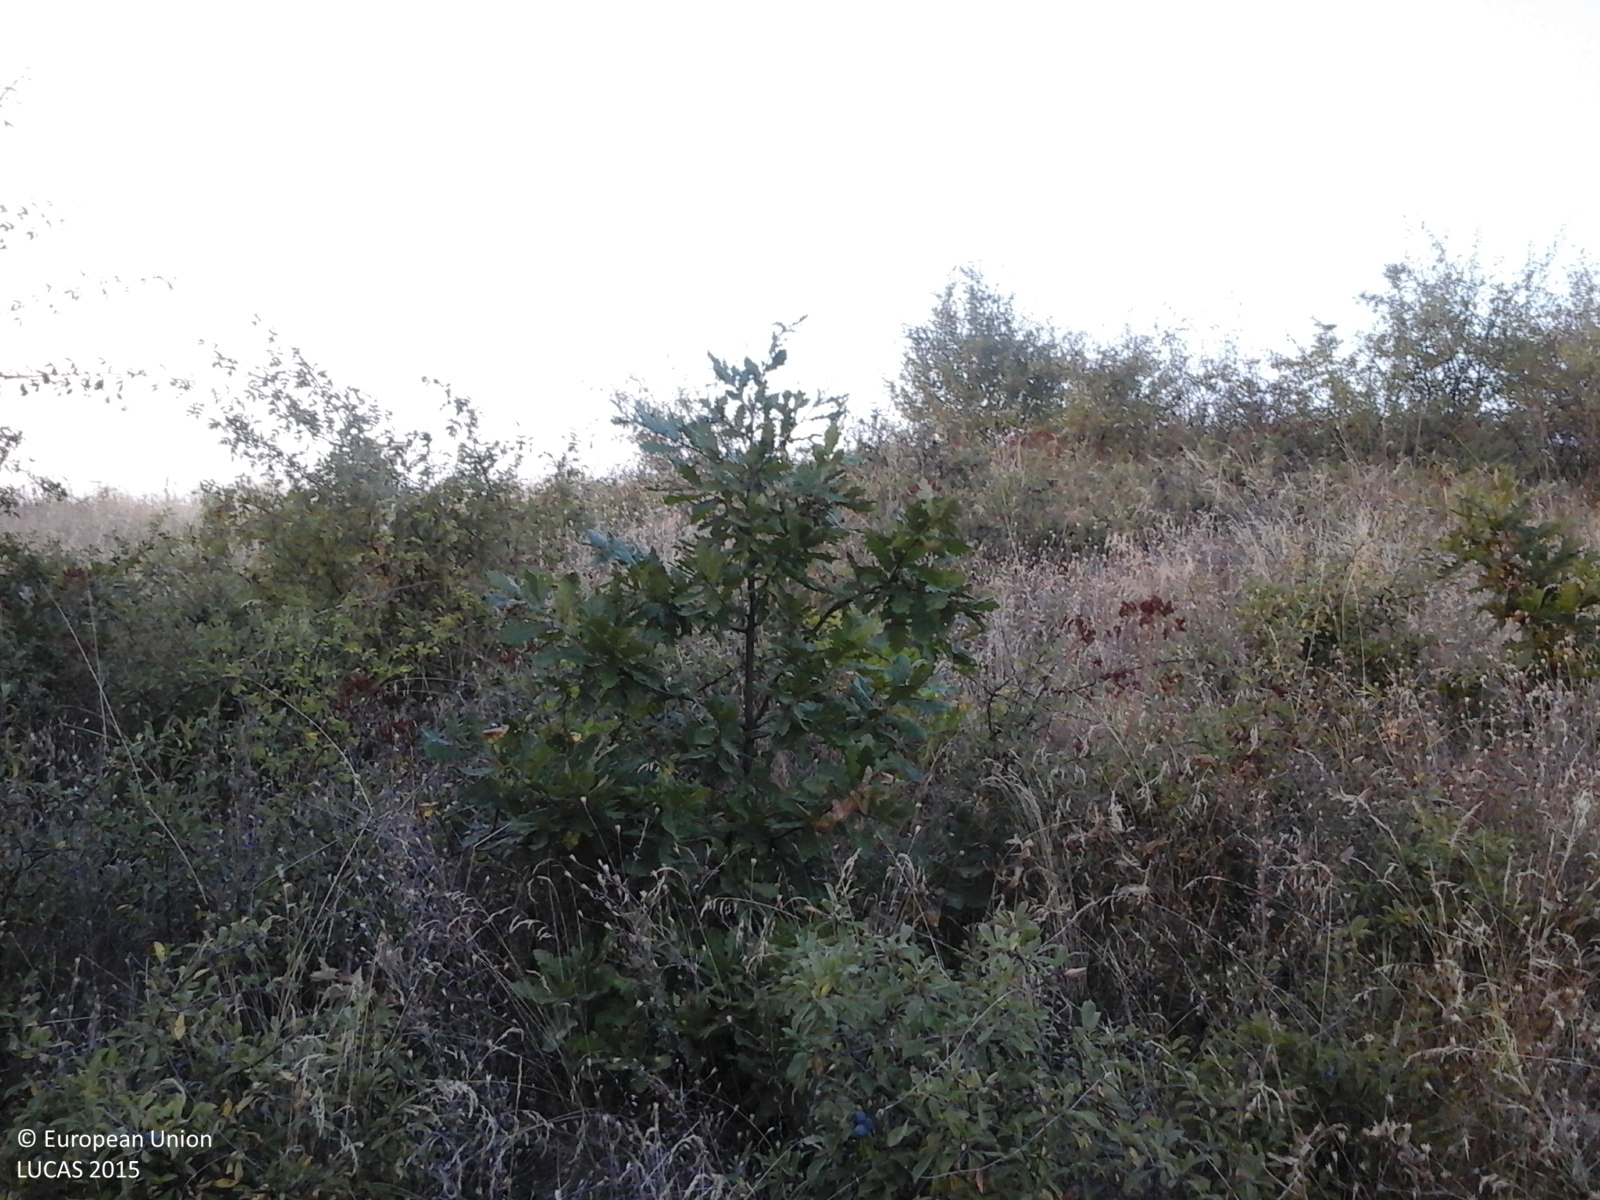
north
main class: Shrubland
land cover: Shrubland with sparse tree cover
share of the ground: > 75 %
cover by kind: shrubs 95 %, broadleaved forest trees 5 %
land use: Semi-natural and natural areas not in use
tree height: < 5 m
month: August
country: RO
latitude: 44.4276
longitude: 23.5317
